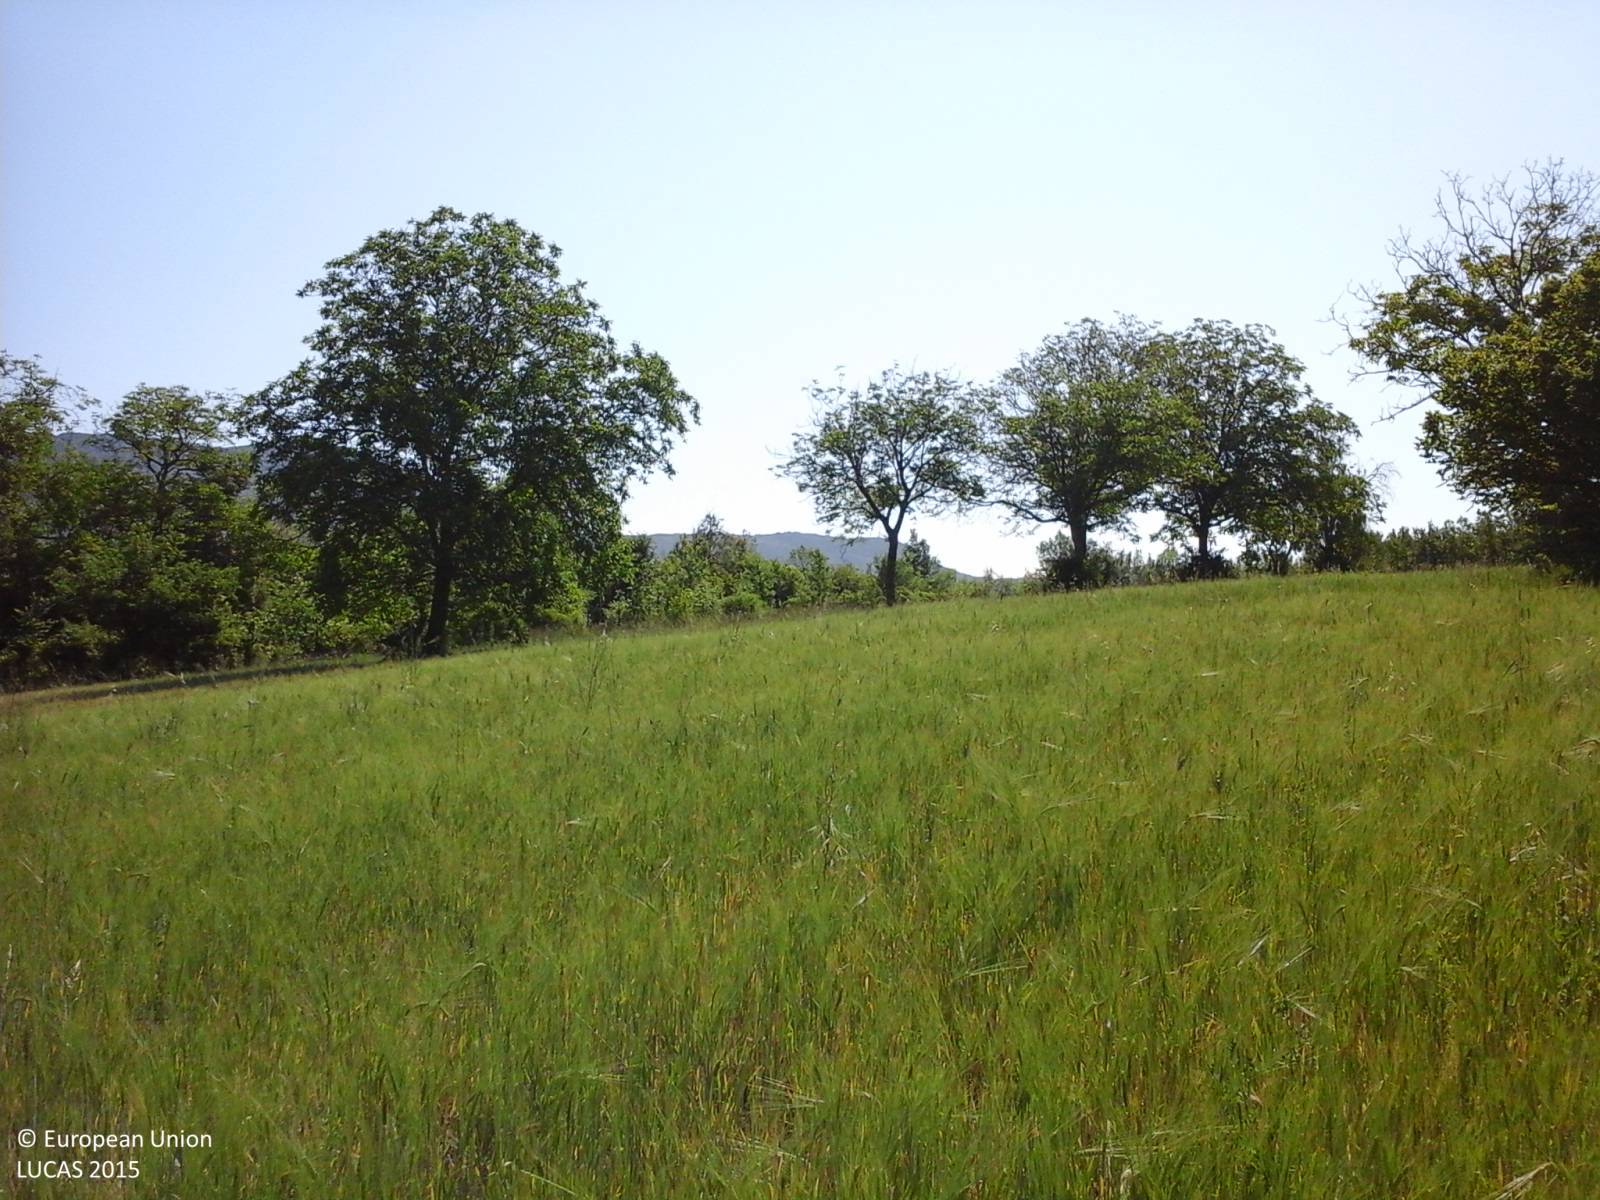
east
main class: Cropland
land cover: Barley
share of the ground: > 75 %
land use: Agriculture (excluding fallow land and kitchen gardens)
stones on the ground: < 10 %
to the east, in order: Barley; Grassland without tree/shrub cover; Abandoned hedges; Fences; Broadleaved woodland; Other bare soil; Fences; Broadleaved woodland; Shrubland with sparse tree cover; Grass margins; Paved roads, cycling and walking lanes; Grass margins; Ditches and canals; Grass margins; Fences; Grassland with sparse tree/shrub cover; Shrubland with sparse tree cover
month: June
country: IT
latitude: 42.1154
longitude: 13.7249
